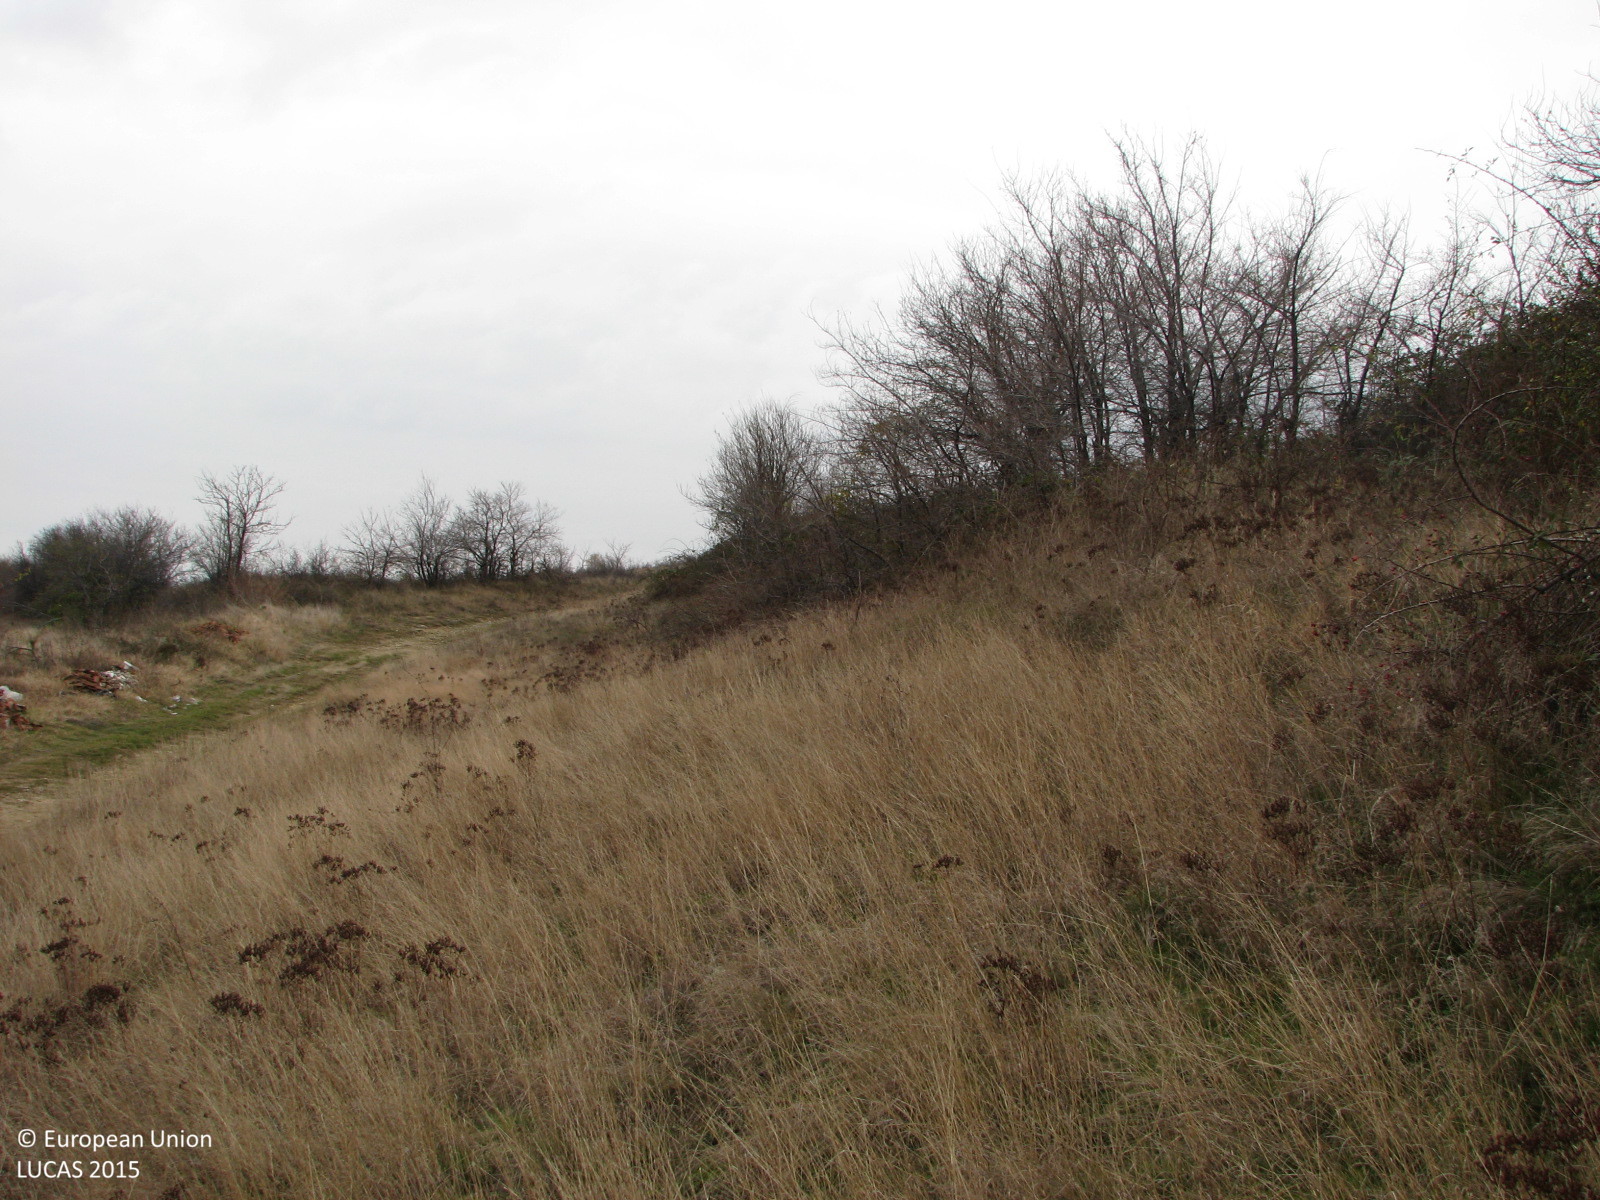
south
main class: Grassland
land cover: Grassland with sparse tree/shrub cover
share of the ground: > 75 %
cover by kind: herbaceous plants 80 %, broadleaved forest trees 5 %, shrubs 5 %, lichens and mosses 5 %, unconsolidated bare surface 5 %
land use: Semi-natural and natural areas not in use
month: December
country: BG
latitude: 42.3304
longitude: 24.0339
